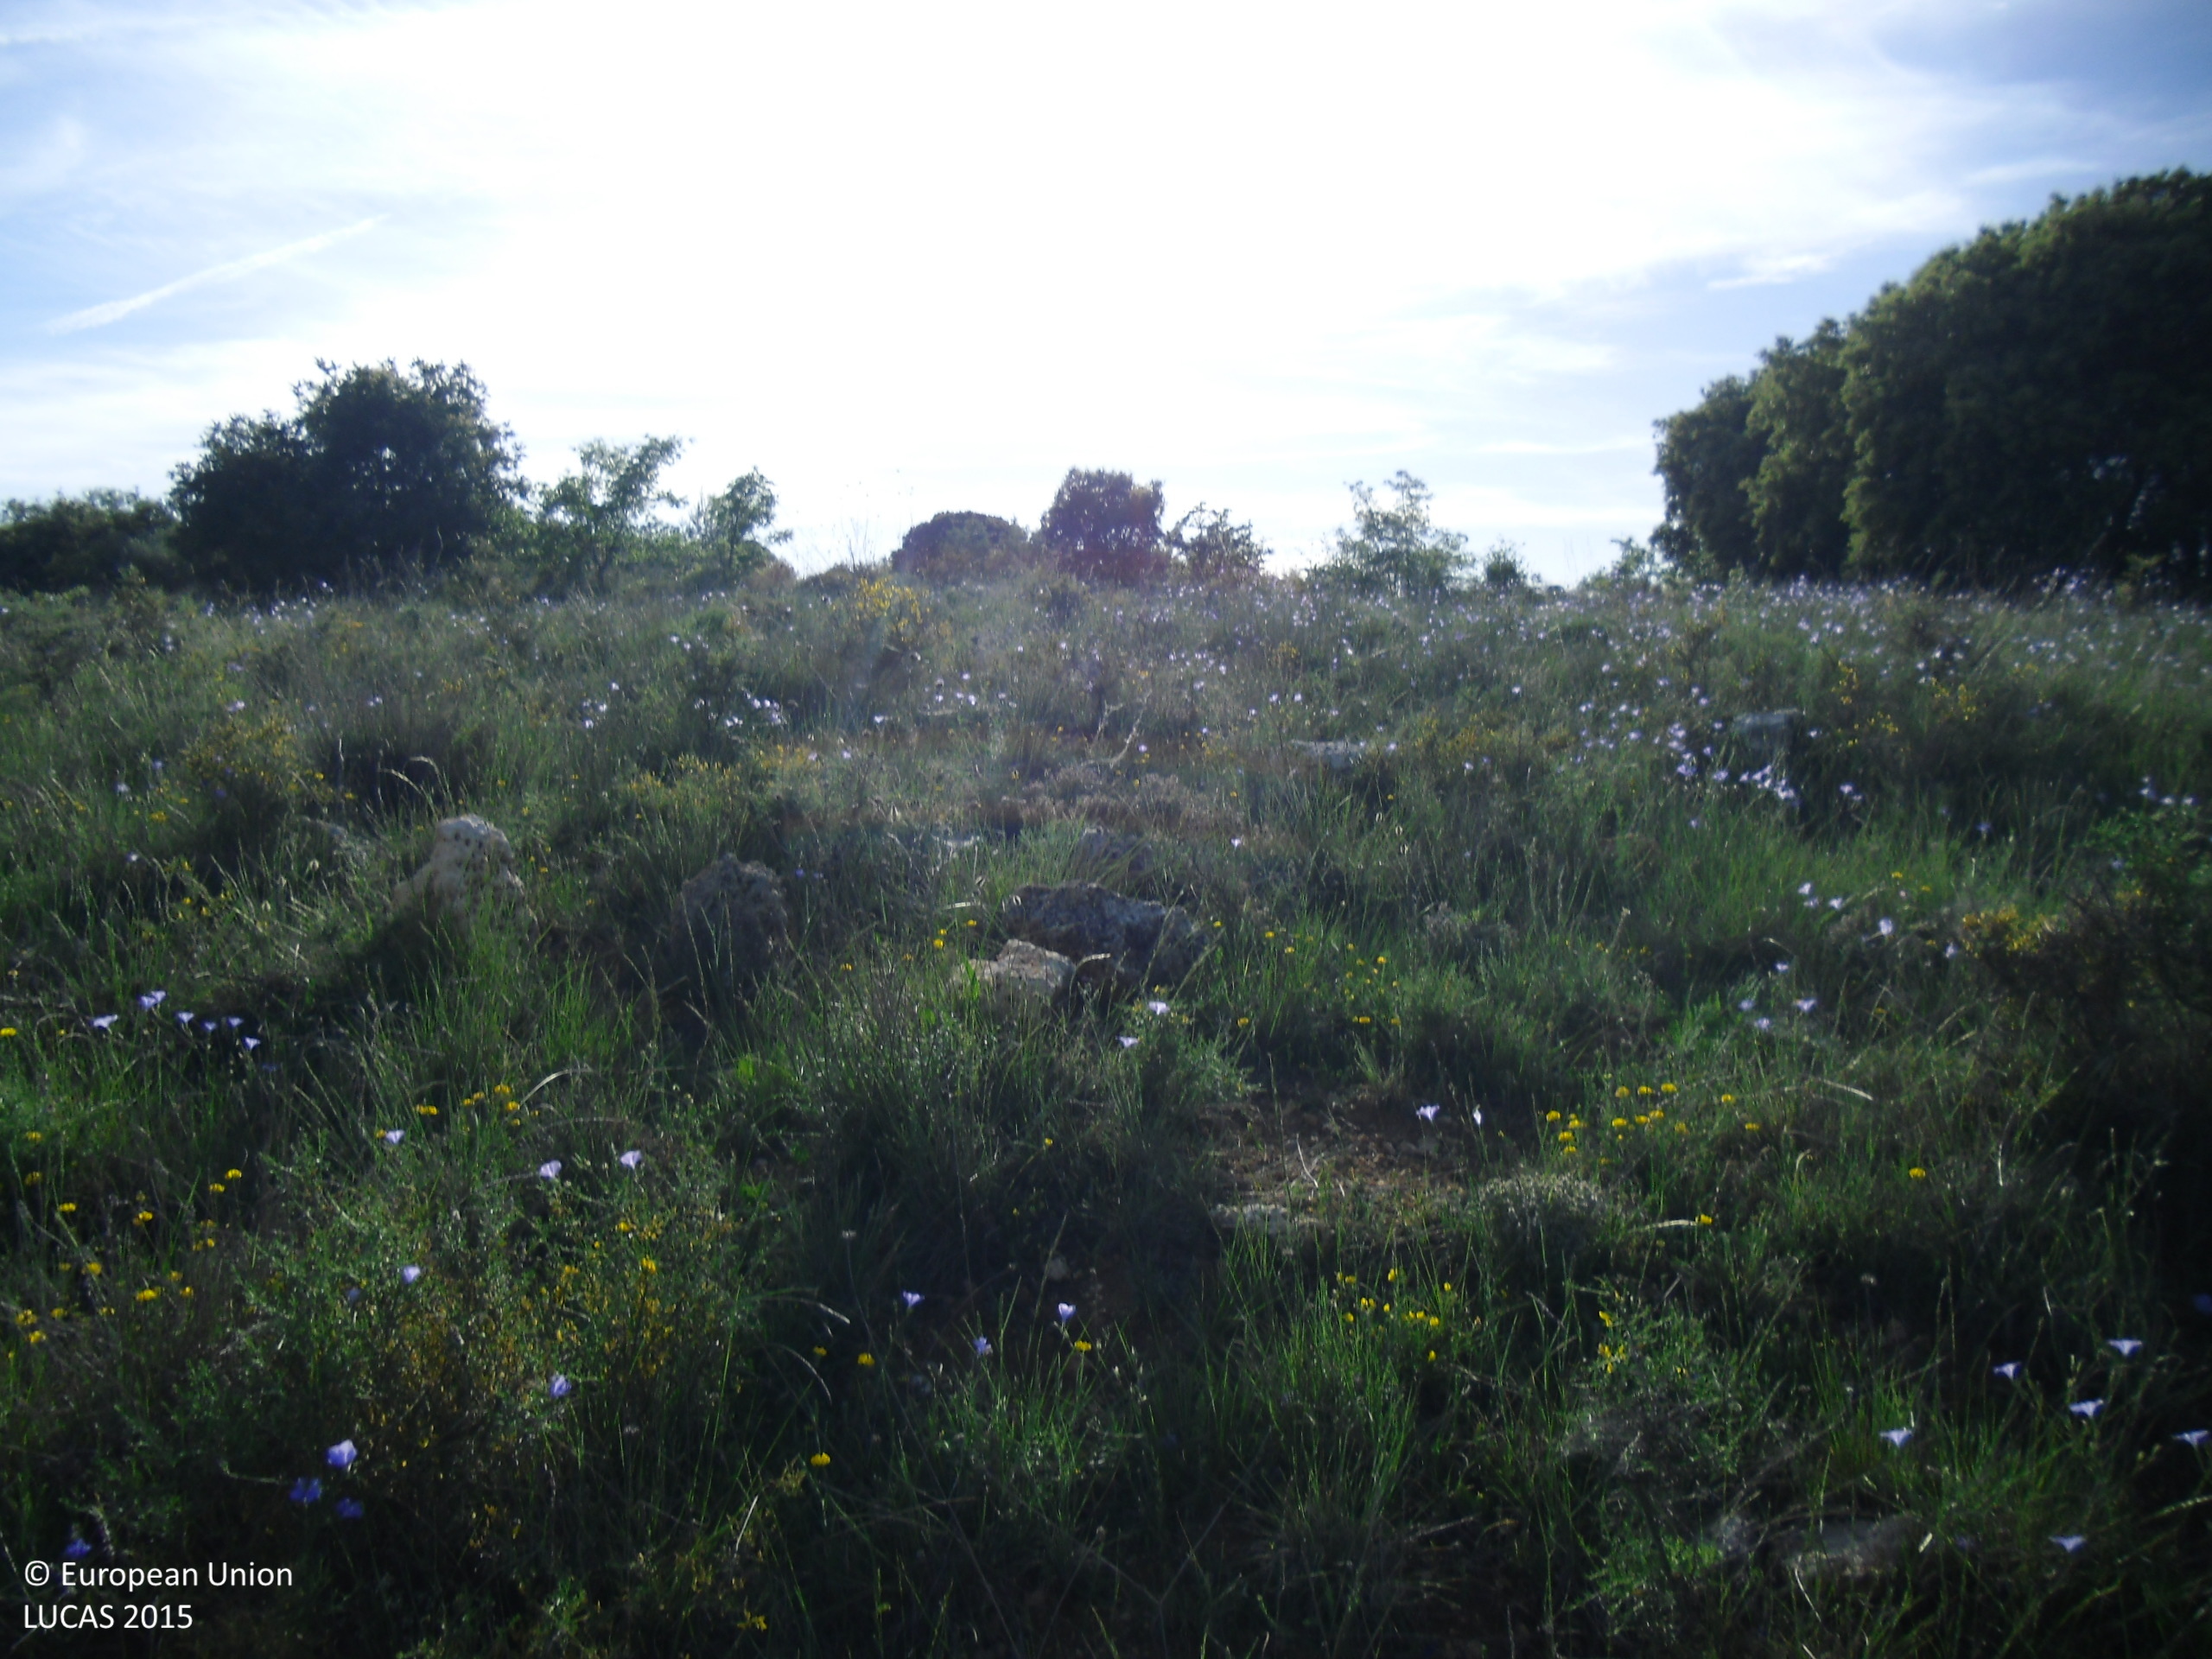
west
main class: Grassland
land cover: Grassland with sparse tree/shrub cover
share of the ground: > 75 %
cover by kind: herbaceous plants 90 %, coniferous forest trees 5 %, shrubs 5 %
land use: Semi-natural and natural areas not in use
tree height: < 5 m
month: May
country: ES
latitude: 40.5236
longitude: -2.9310
